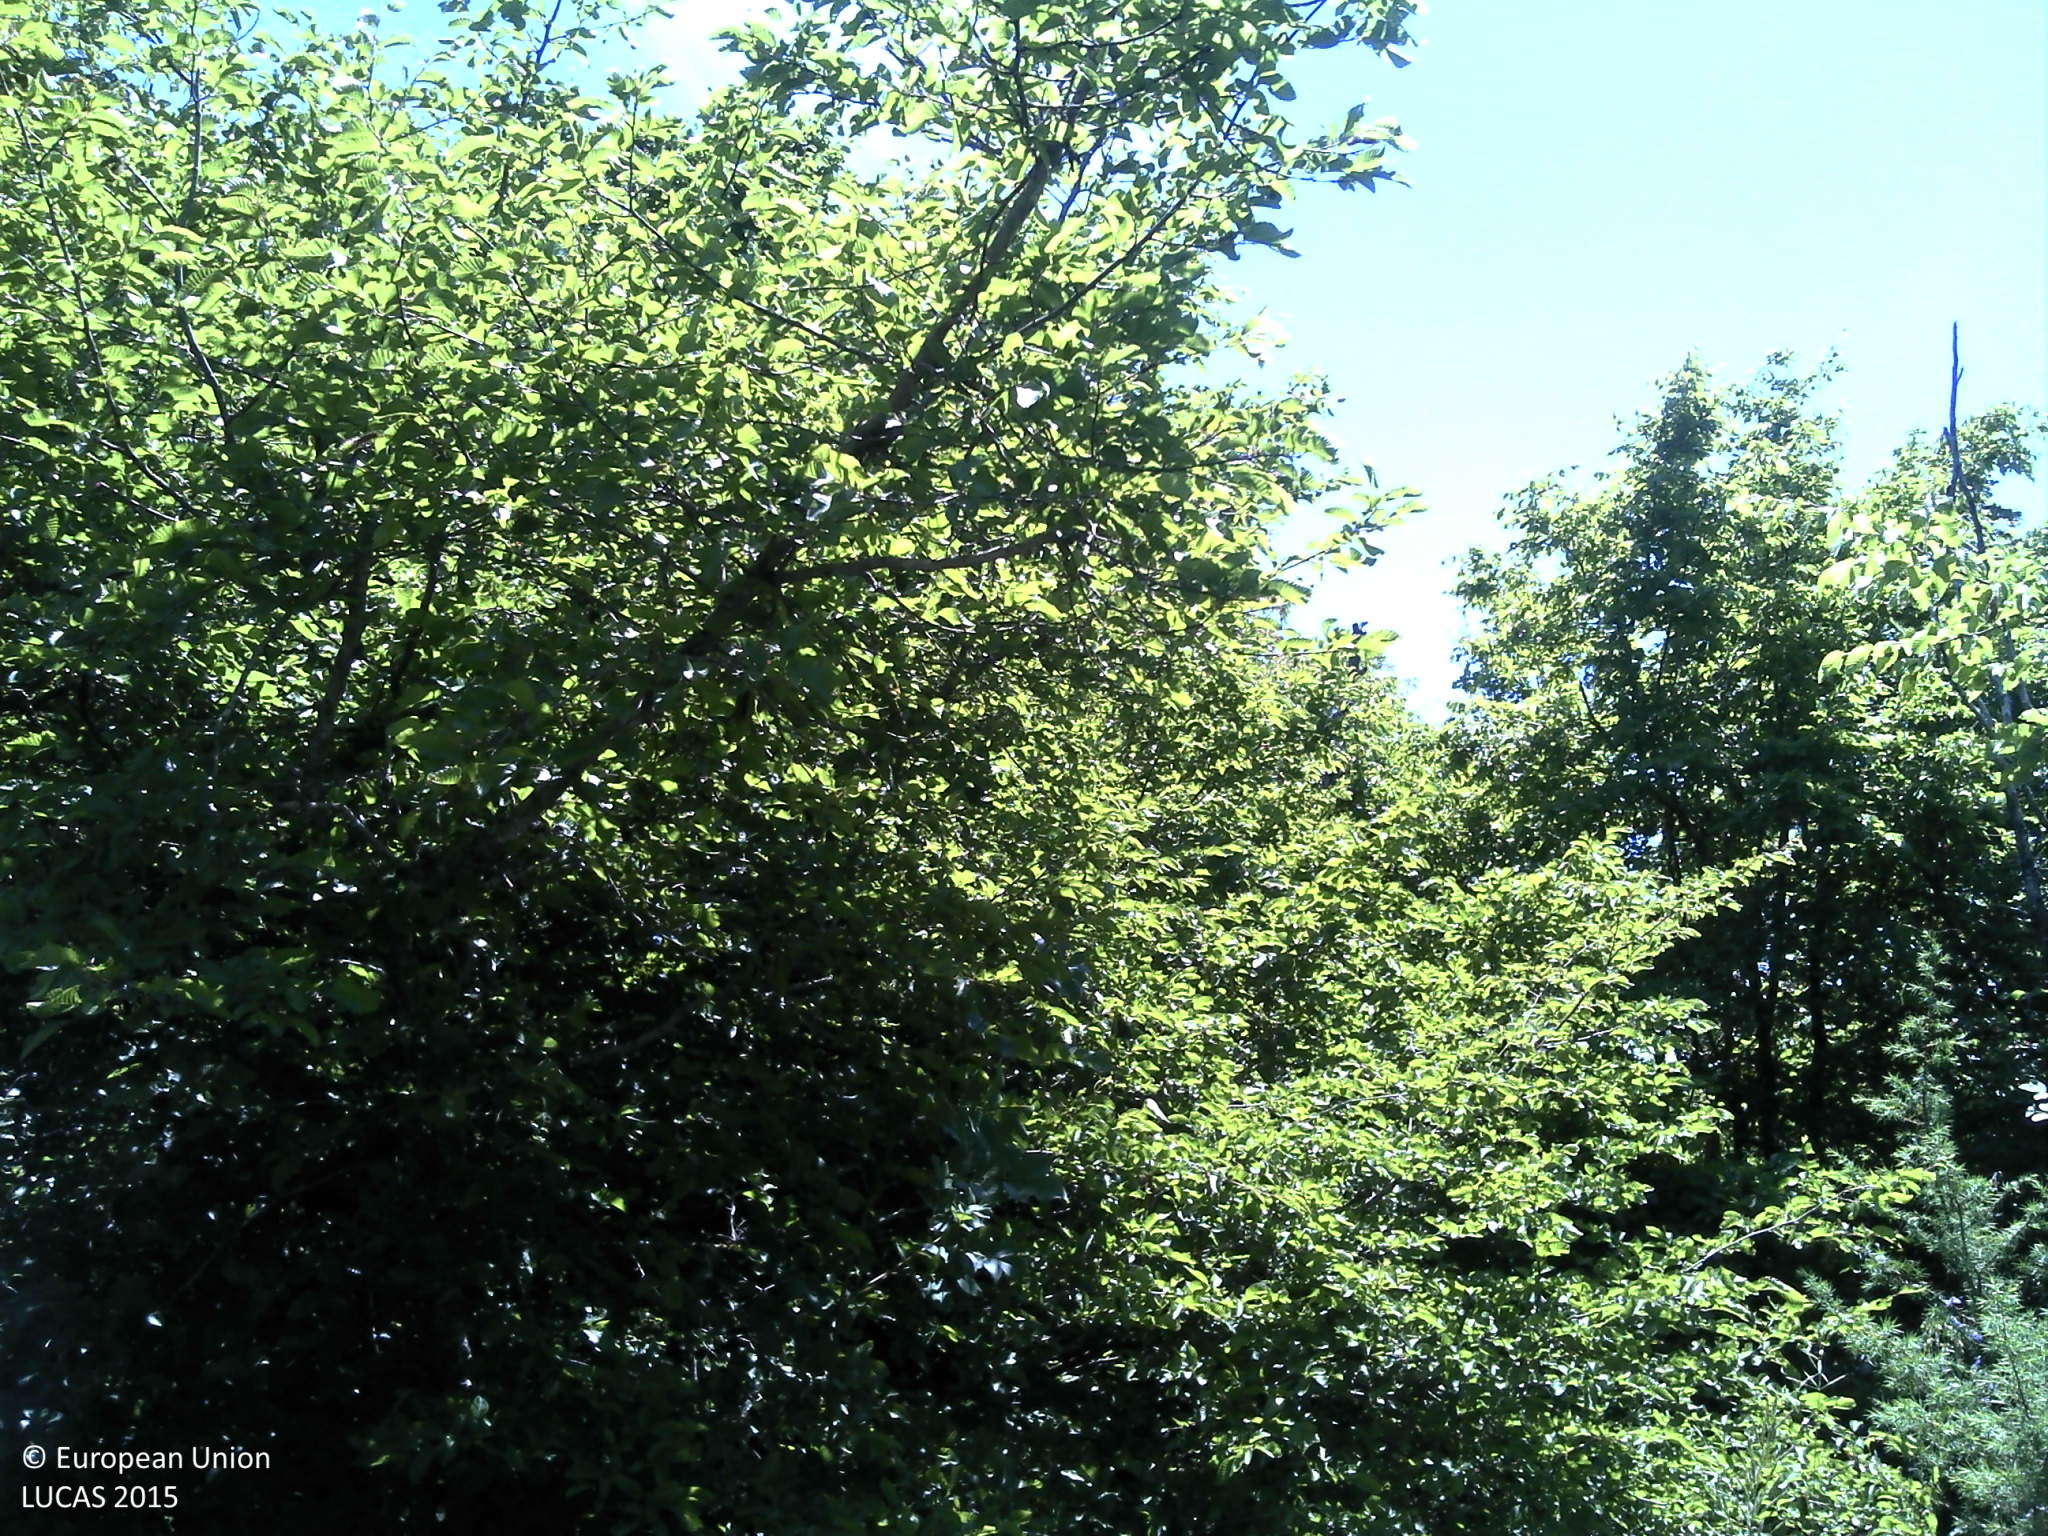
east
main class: Woodland
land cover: Broadleaved woodland
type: thermophilous deciduous forest
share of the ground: > 75 %
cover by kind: broadleaved forest trees 75 %, herbaceous plants 15 %, shrubs 5 %, unconsolidated bare surface 5 %
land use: Semi-natural and natural areas not in use
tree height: < 5 m
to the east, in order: Broadleaved woodland; Dry stone walls; Broadleaved woodland; Grassland with sparse tree/shrub cover; Shrubland with sparse tree cover; Dry stone walls; Broadleaved woodland
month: June
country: HR
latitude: 43.7468
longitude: 16.2378
